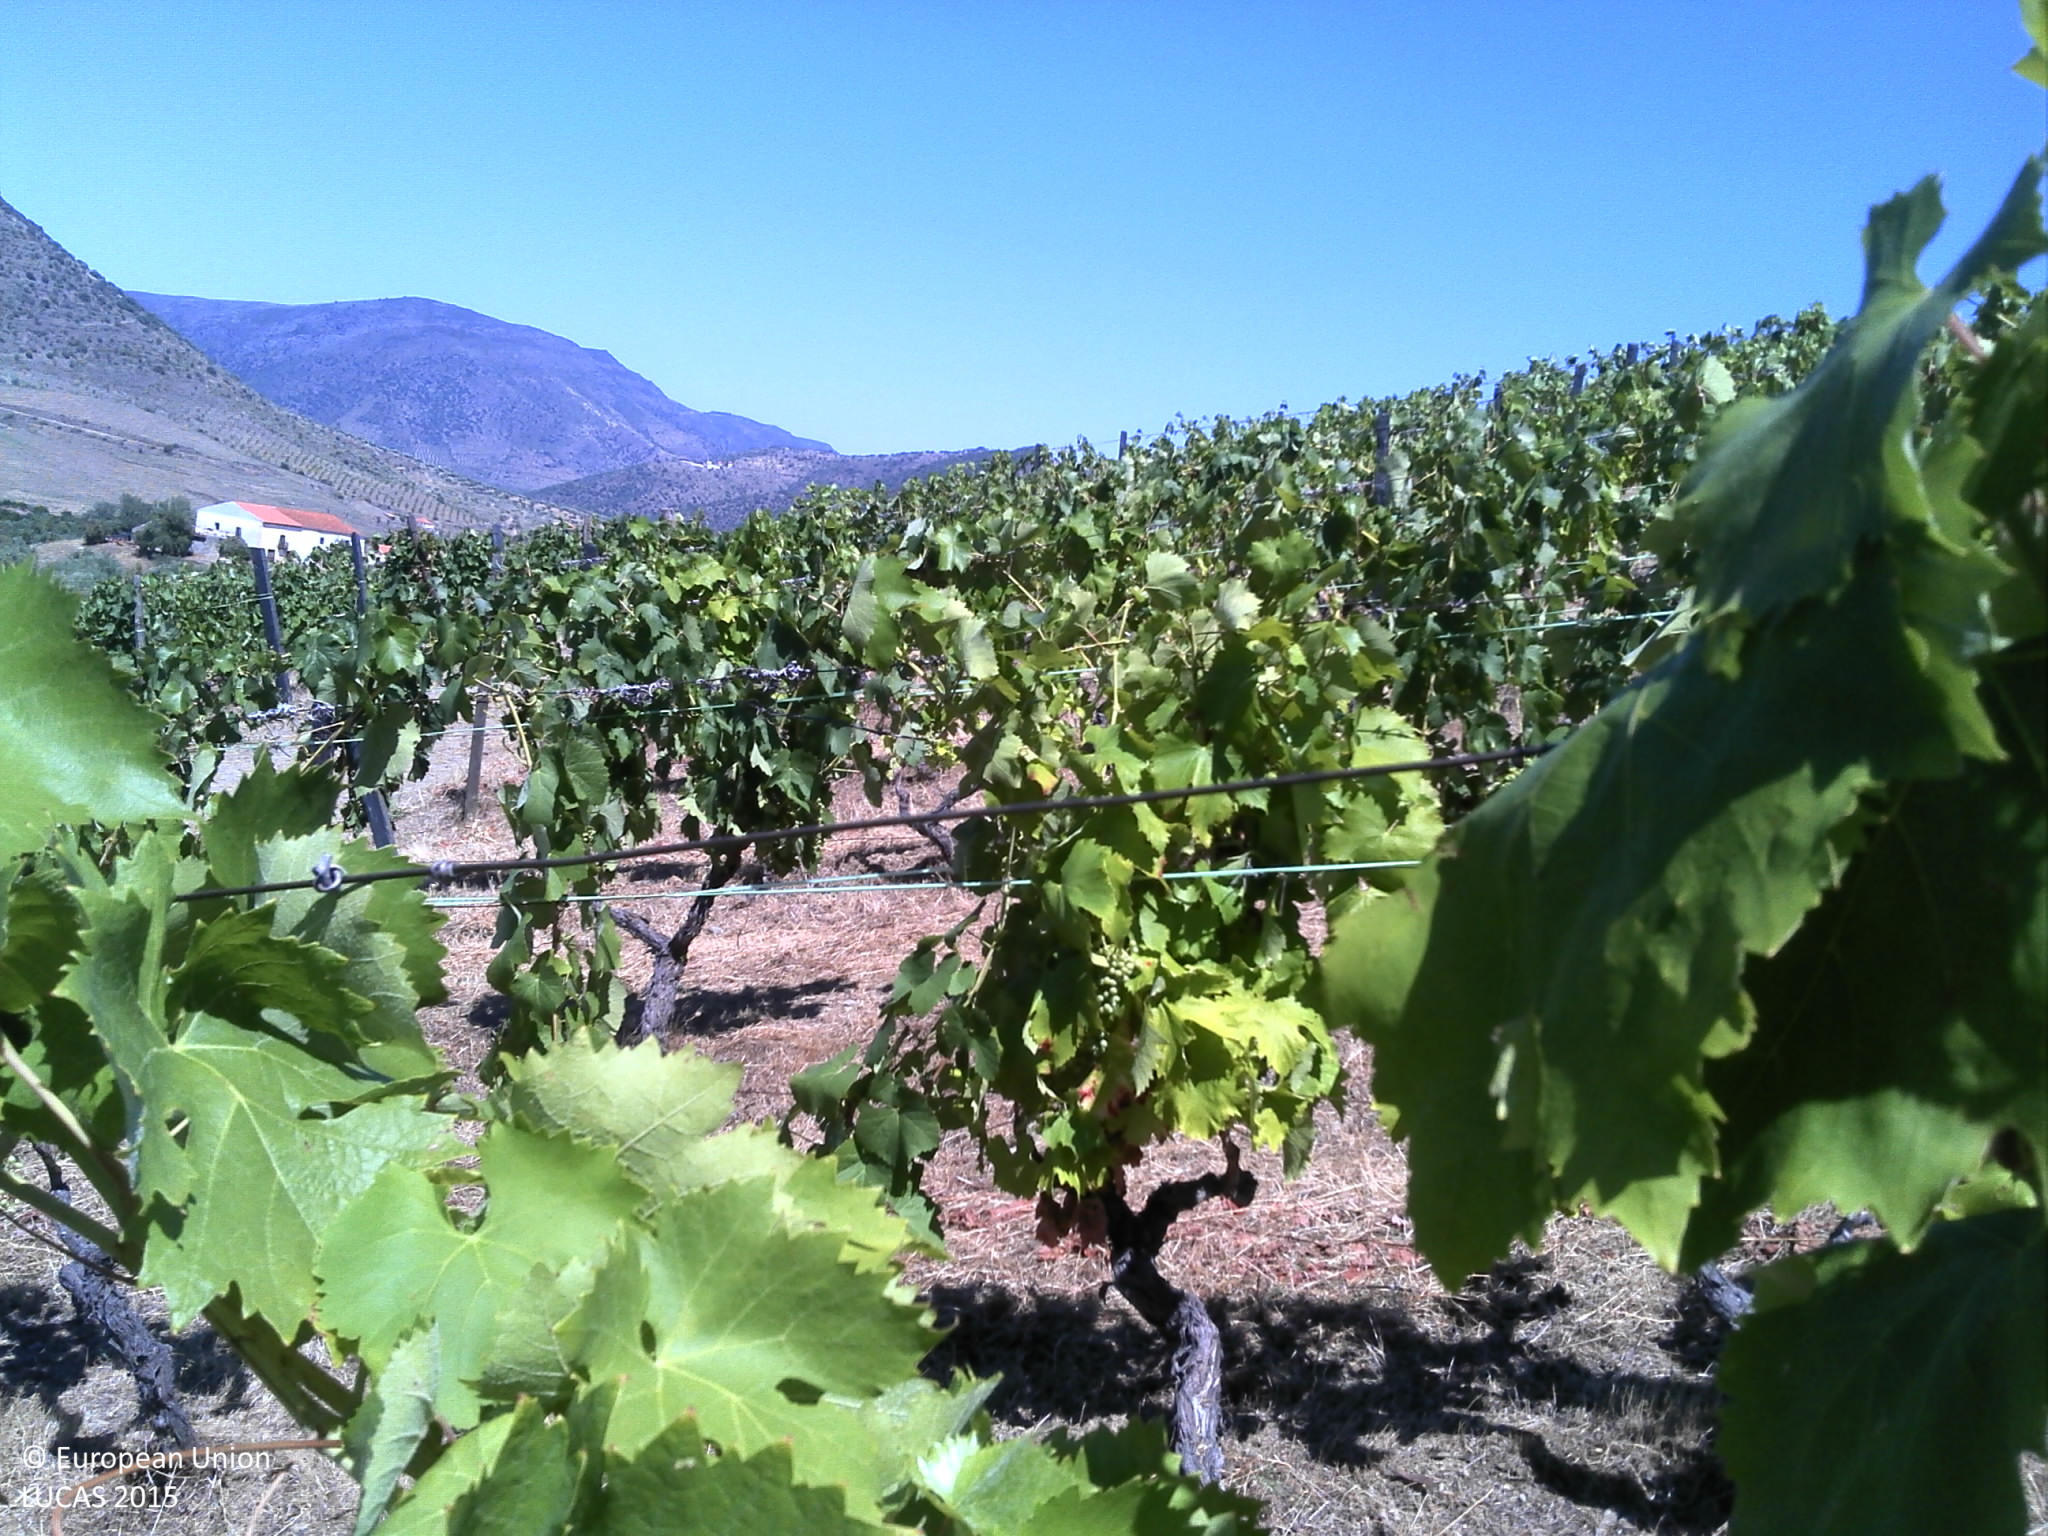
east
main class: Cropland
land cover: Vineyards
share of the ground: 10 - 25 %
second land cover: Grassland without tree/shrub cover
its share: > 75 %
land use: Agriculture (excluding fallow land and kitchen gardens)
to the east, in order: Vineyards; Grassland without tree/shrub cover; Vineyards; Tracks; Single bushes/trees; Tracks; Fences; Olive groves; Ditches and canals; Olive groves
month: June
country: PT
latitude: 41.0273
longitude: -6.9593
